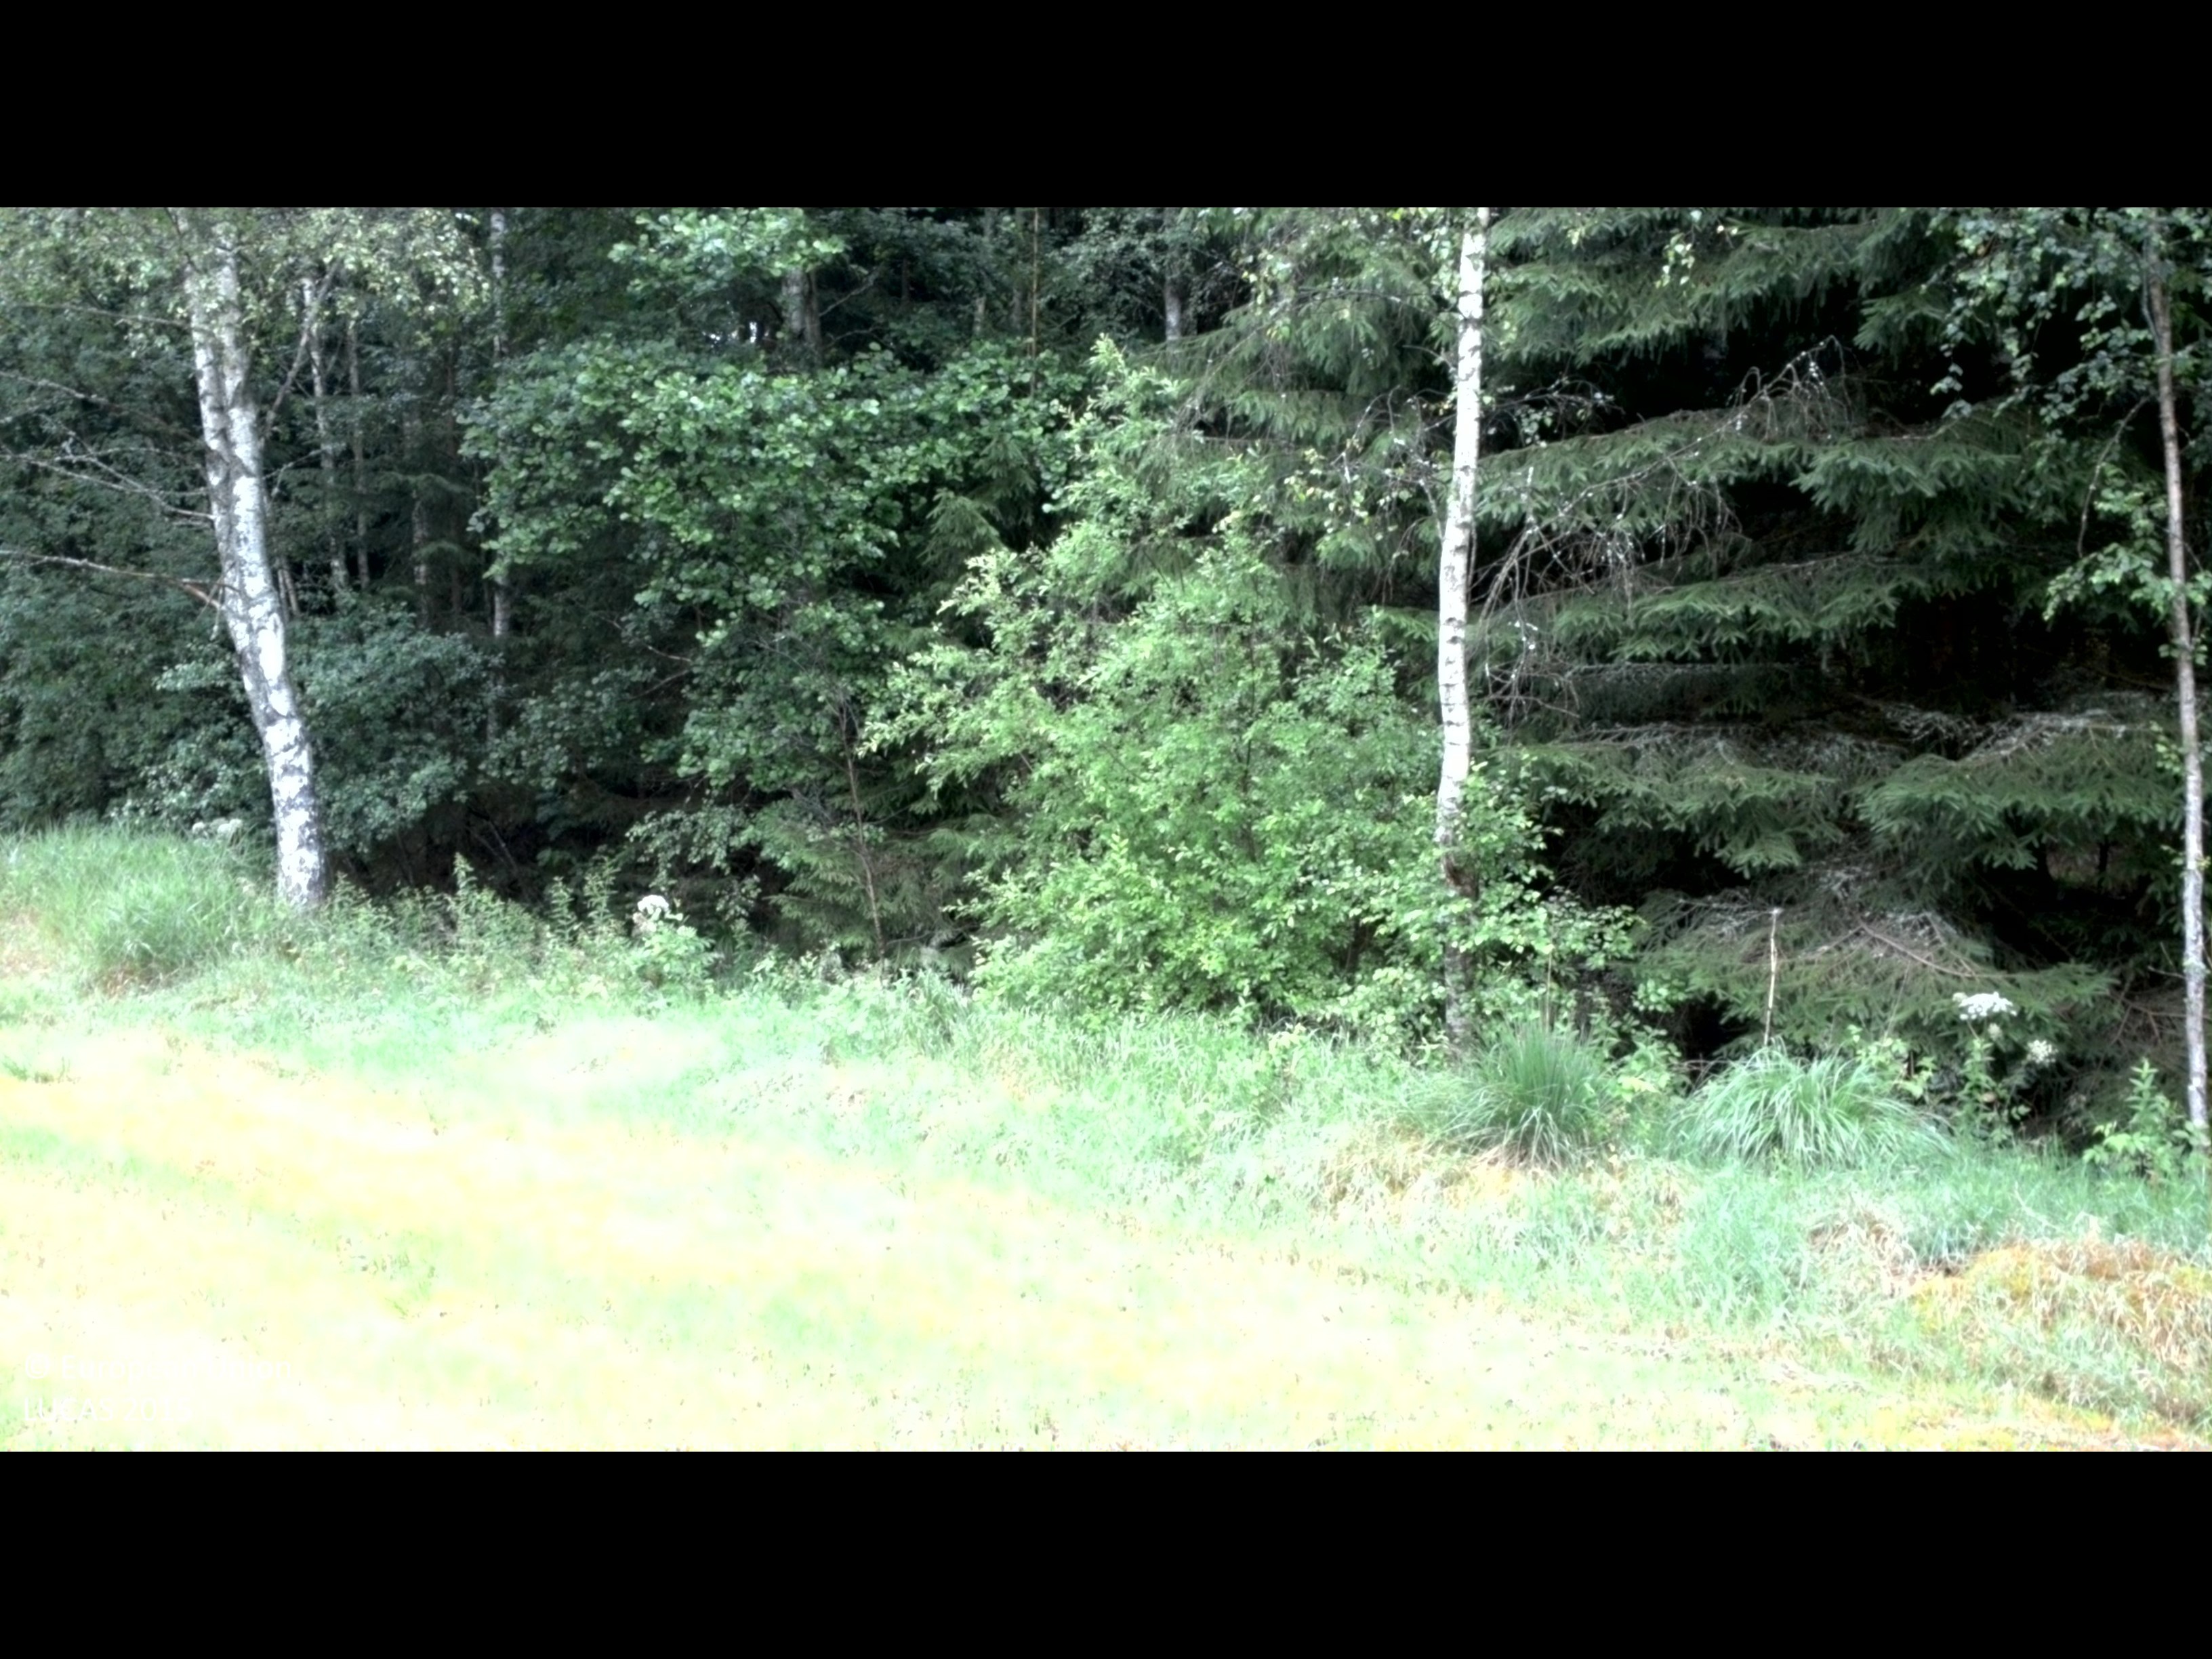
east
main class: Grassland
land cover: Grassland without tree/shrub cover
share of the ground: 50 - 75 %
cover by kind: herbaceous plants 60 %, lichens and mosses 40 %
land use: Agriculture (excluding fallow land and kitchen gardens)
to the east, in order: Grassland without tree/shrub cover; Groves; Rivers and streams; Spruce dominated mixed woodland; Broadleaved woodland; Spruce dominated mixed woodland; Tracks; Spruce dominated mixed woodland; Broadleaved woodland; Artificial constructions in urban areas
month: July
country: SE
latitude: 56.4843
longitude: 14.0406
